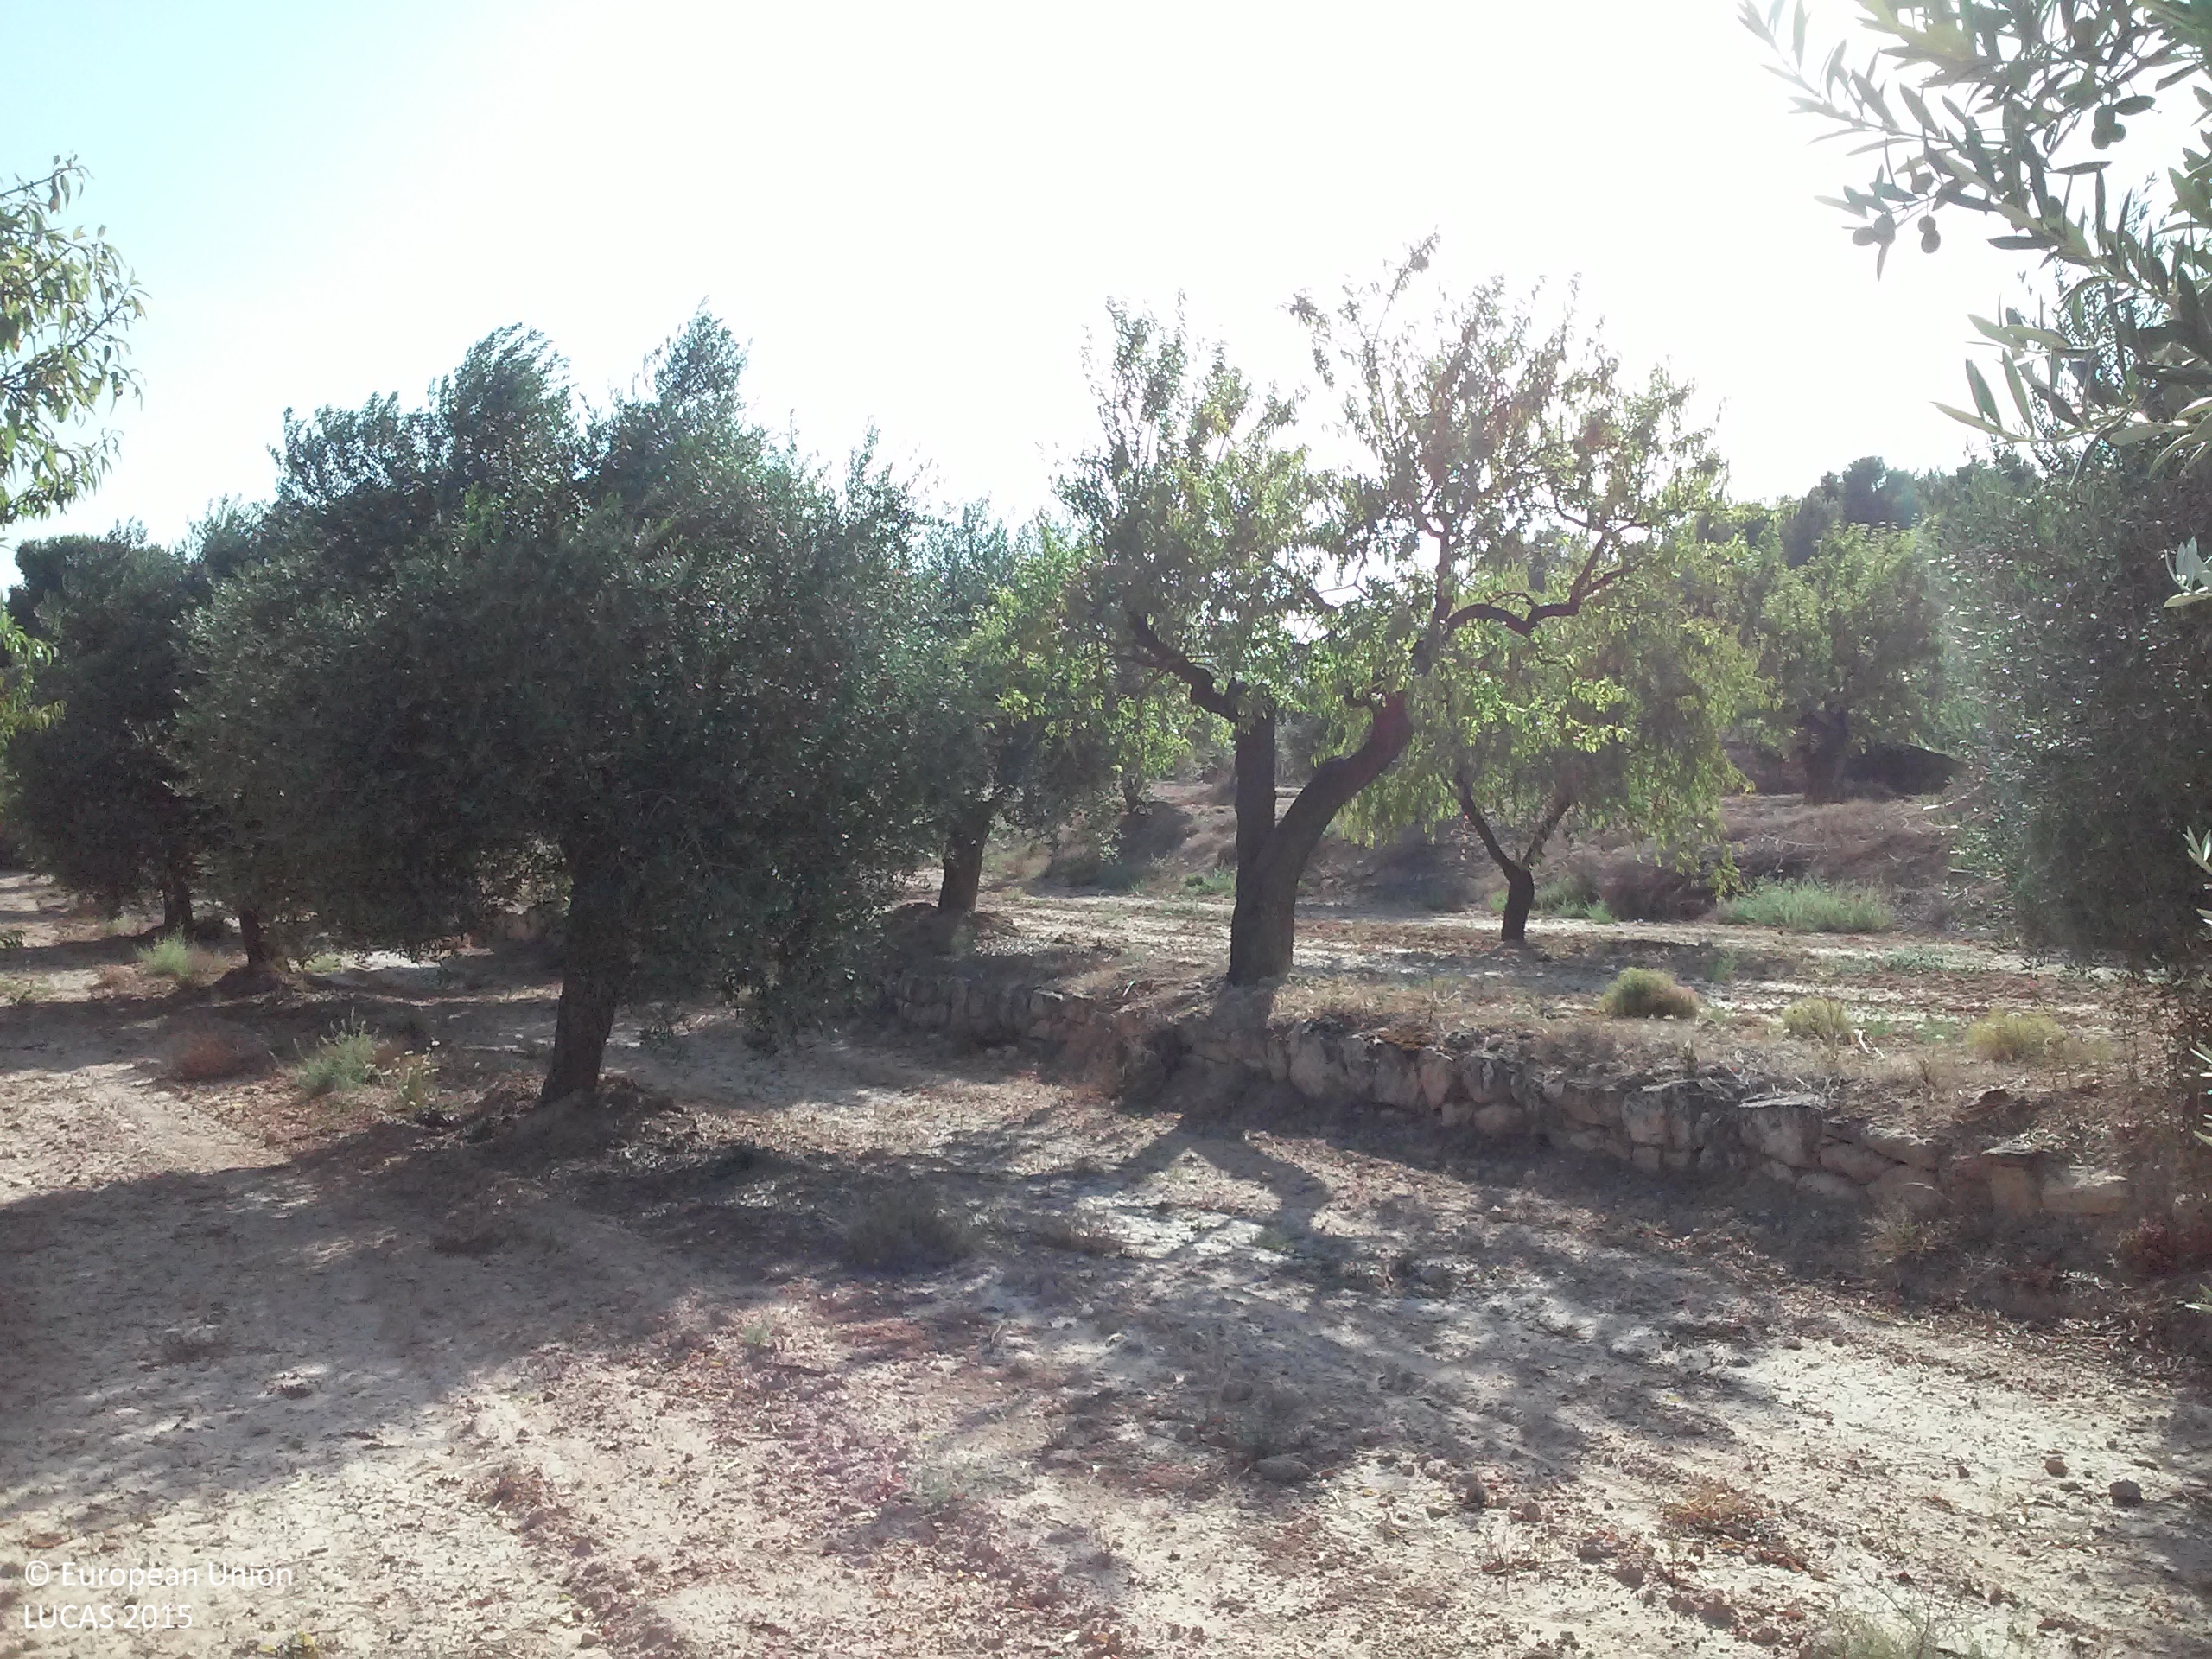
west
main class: Cropland
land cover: Olive groves
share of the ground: 10 - 25 %
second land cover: Nuts trees
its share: 10 - 25 %
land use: Agriculture (excluding fallow land and kitchen gardens)
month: August
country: ES
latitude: 41.3779
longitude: 0.5792
